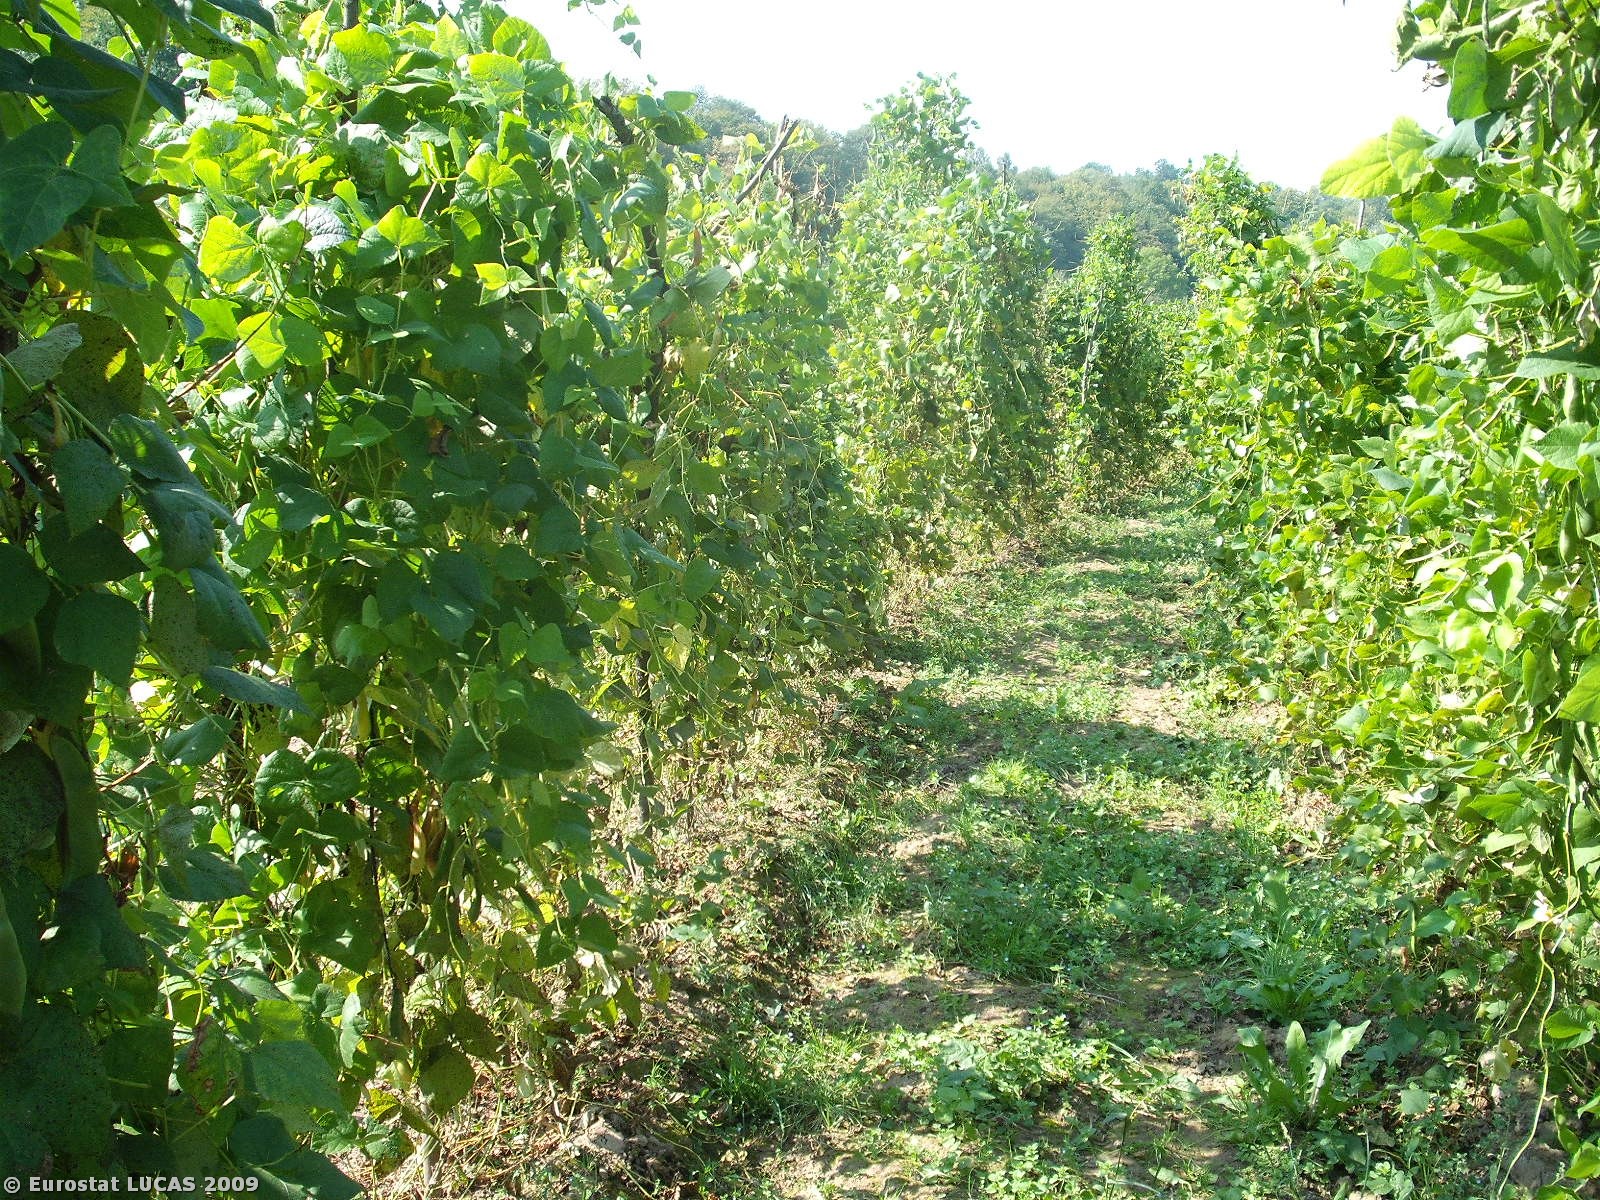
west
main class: Cropland
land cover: Dry pulses
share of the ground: 25 - 50 %
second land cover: Spontaneously vegetated surfaces
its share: 50 - 75 %
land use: Agriculture (excluding fallow land and kitchen gardens)
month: September
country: PL
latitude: 49.7483
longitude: 20.5438
